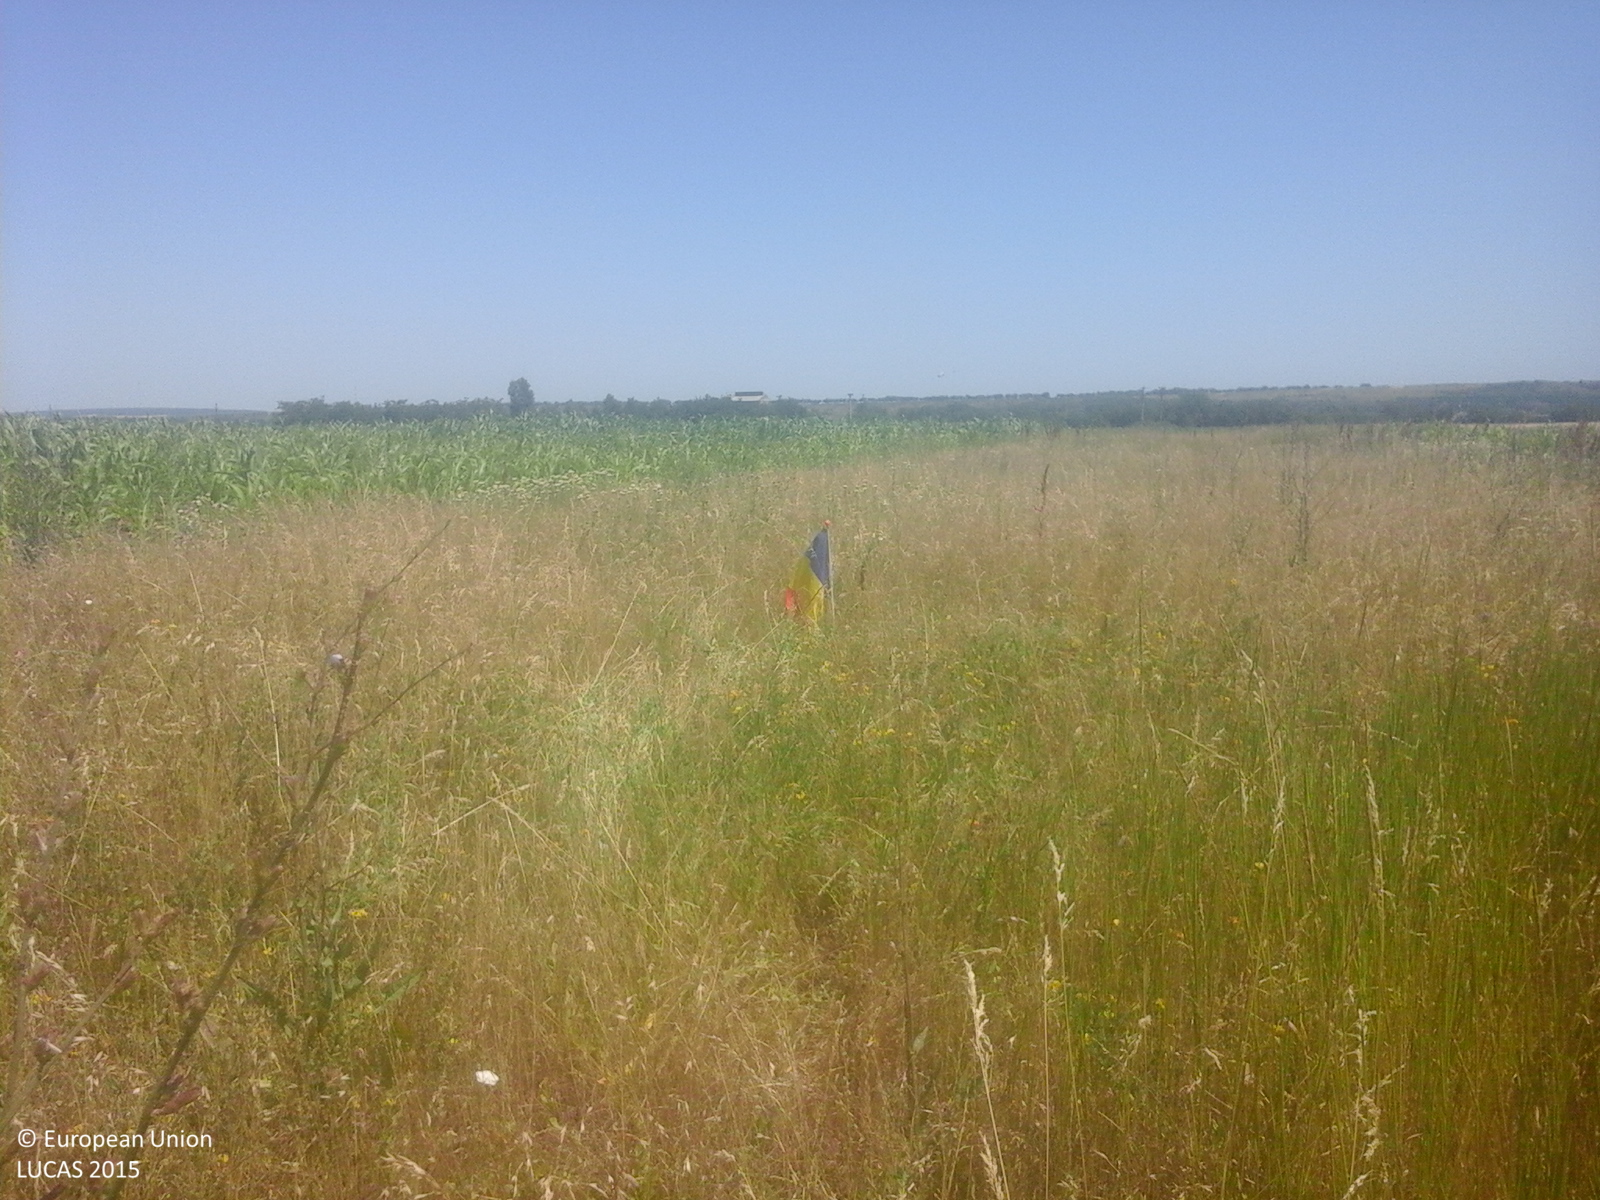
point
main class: Grassland
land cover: Grassland without tree/shrub cover
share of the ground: > 75 %
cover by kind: herbaceous plants 100 %
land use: Agriculture (excluding fallow land and kitchen gardens)
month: June
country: RO
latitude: 47.0793
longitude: 27.8676
